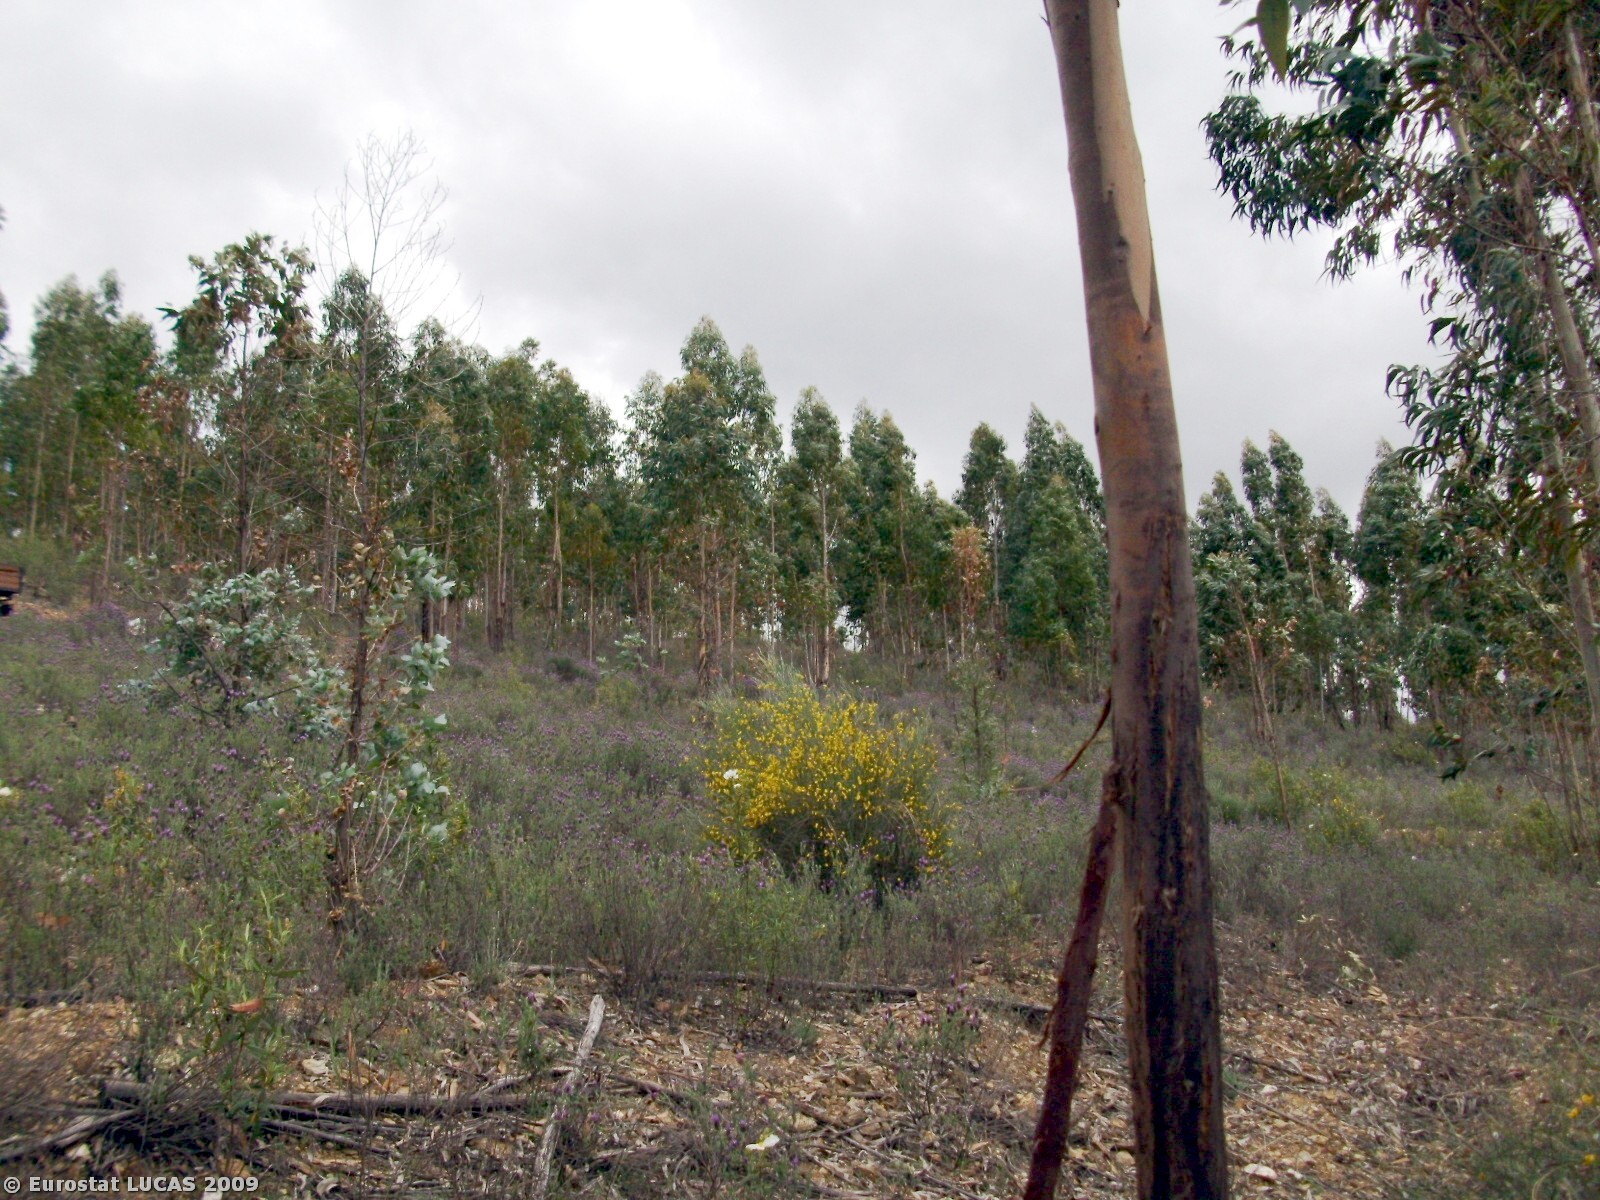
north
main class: Woodland
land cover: Broadleaved woodland
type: plantations and self-sown exotic forest
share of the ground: 50 - 75 %
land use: Forestry
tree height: > 5 m
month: April
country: PT
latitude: 39.6511
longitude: -7.5435
